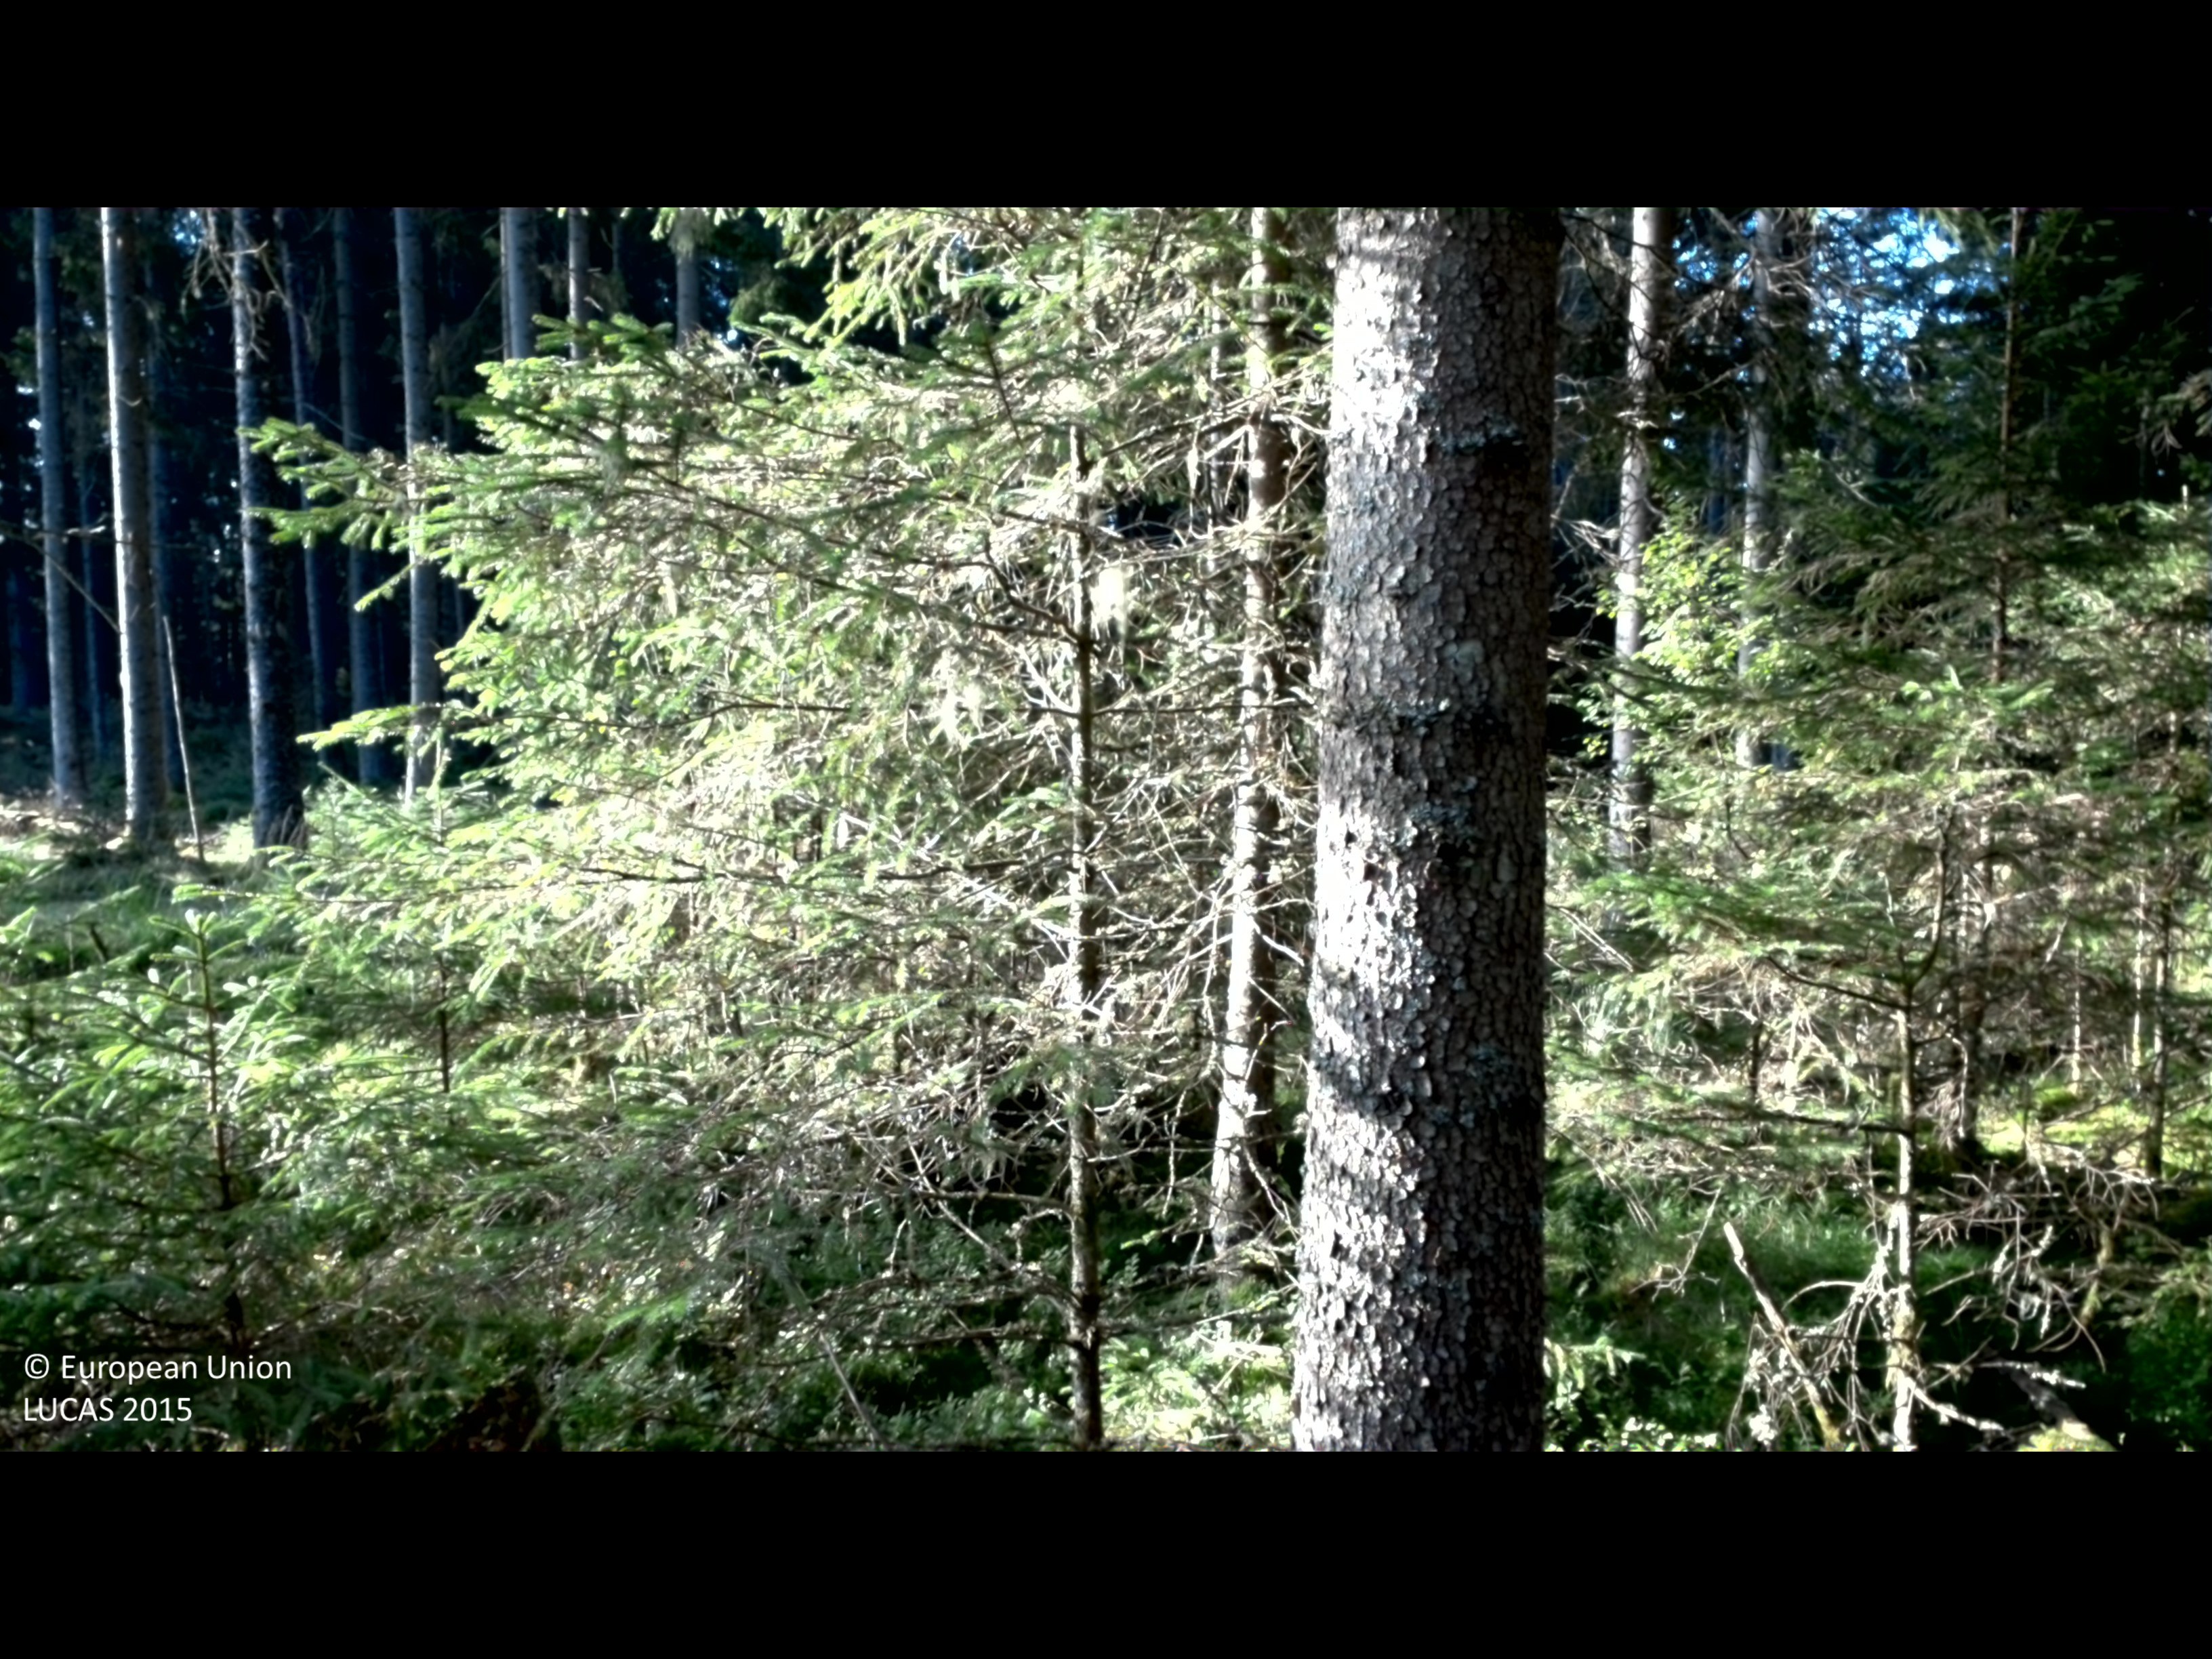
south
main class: Woodland
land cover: Spruce dominated coniferous woodland
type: boreal forest
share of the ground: 50 - 75 %
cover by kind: coniferous forest trees 60 %, shrubs 15 %, lichens and mosses 15 %, herbaceous plants 10 %
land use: Forestry
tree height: > 5 m
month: September
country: SE
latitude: 57.1020
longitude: 13.1823
